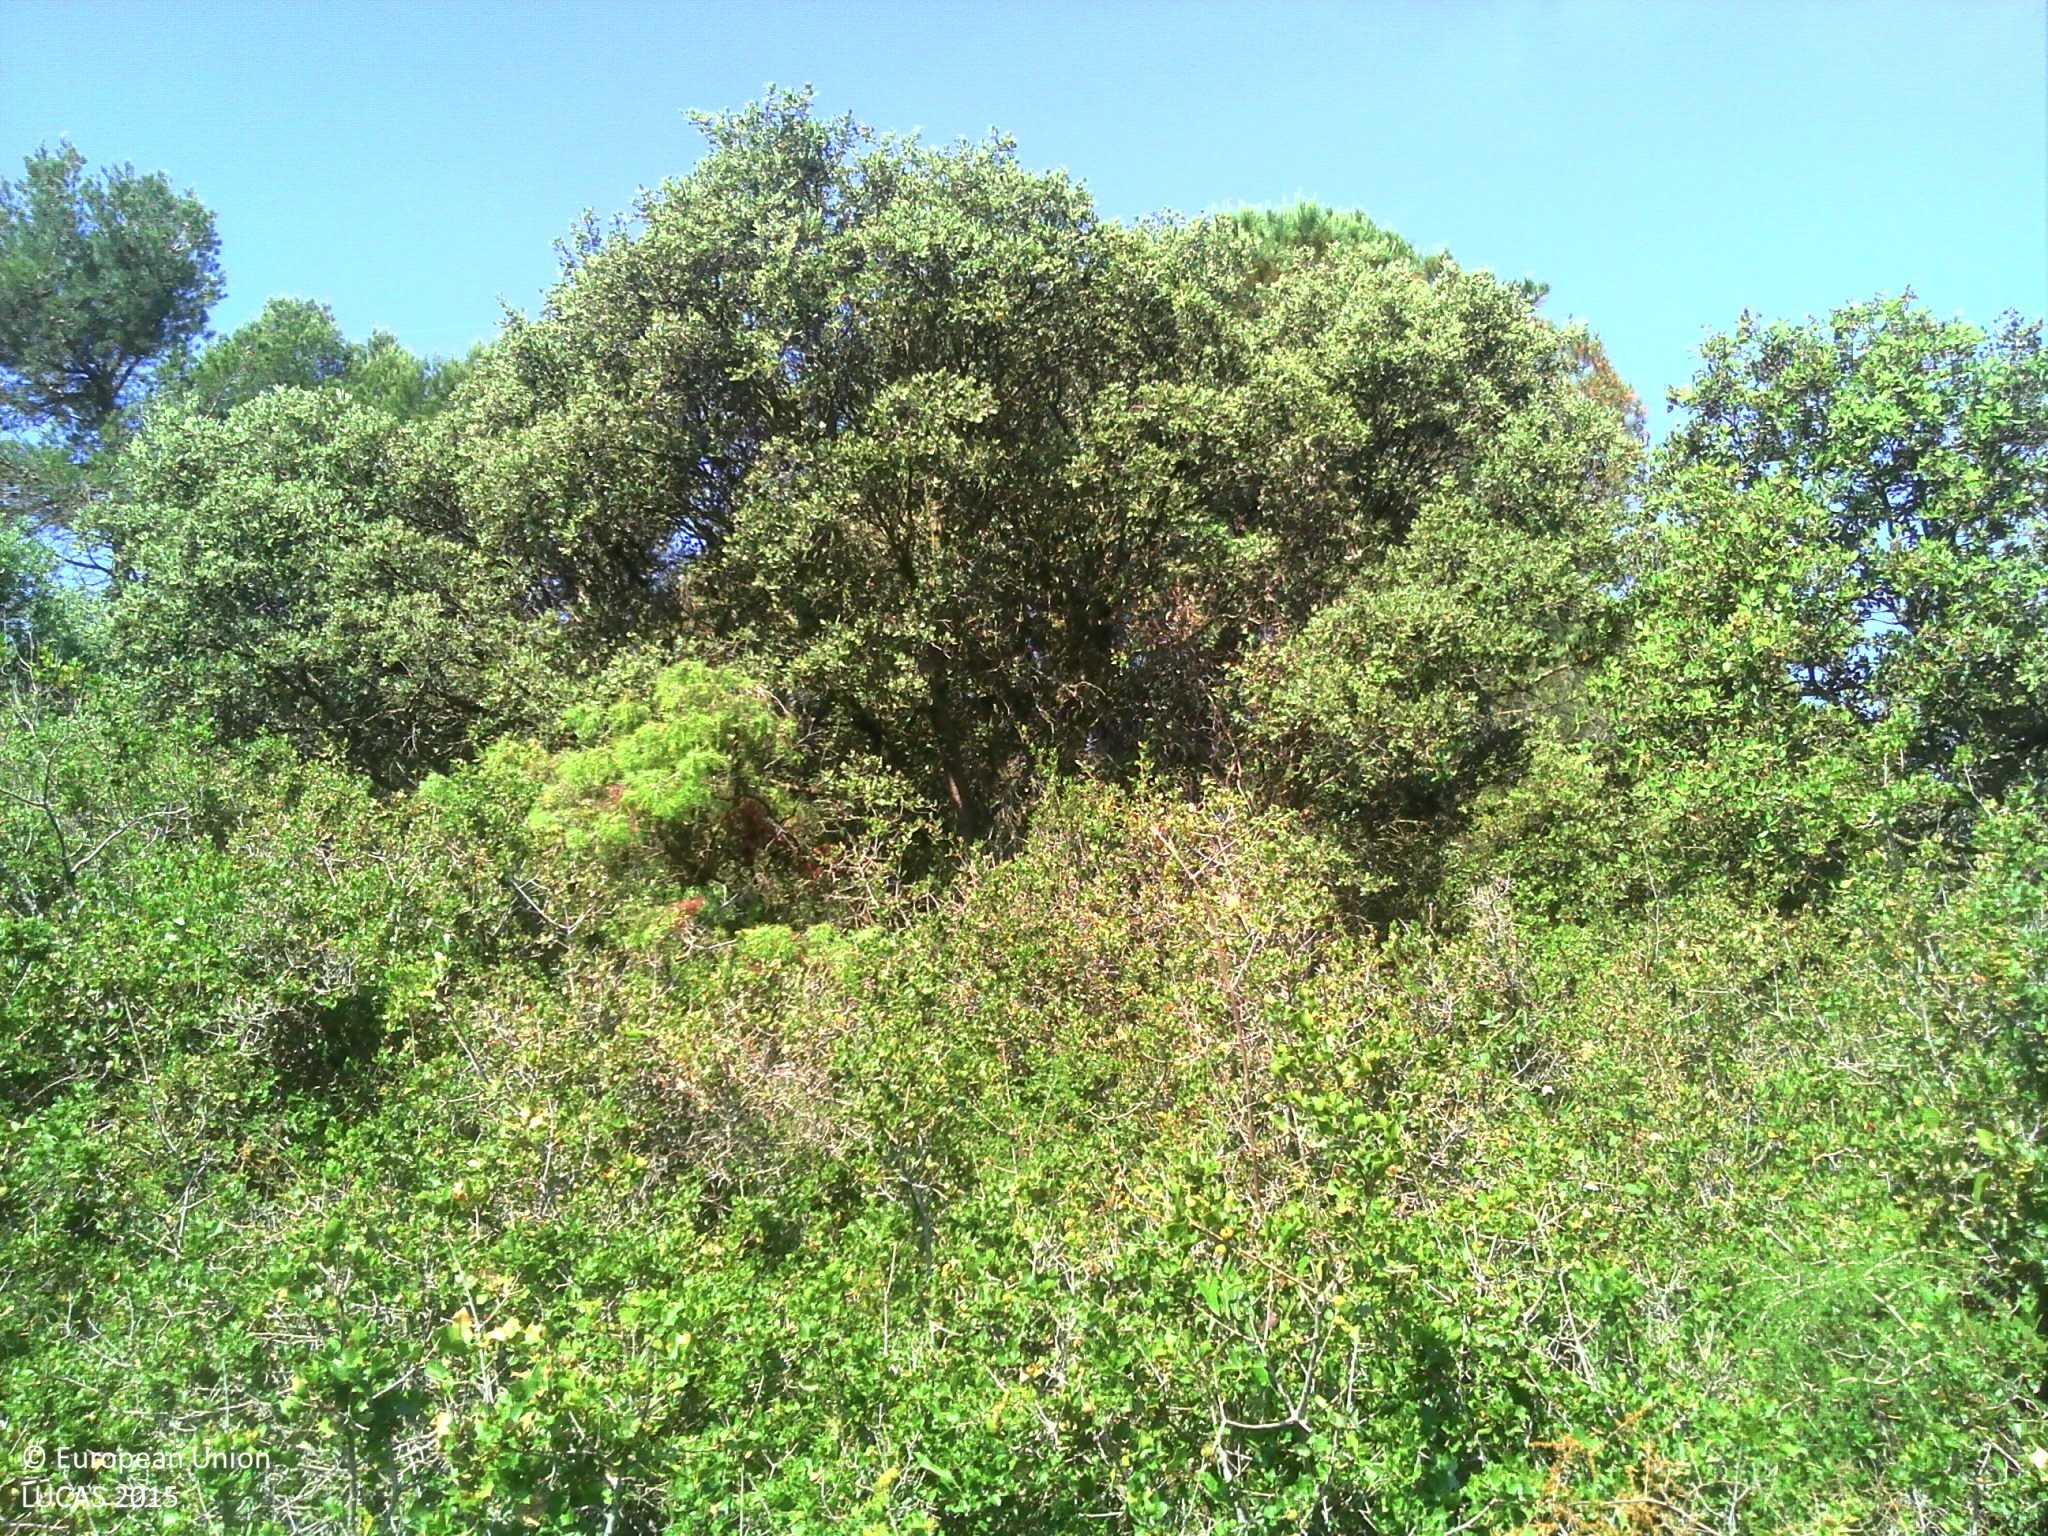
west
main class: Shrubland
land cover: Shrubland with sparse tree cover
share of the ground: > 75 %
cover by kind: shrubs 95 %, coniferous forest trees 5 %
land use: Semi-natural and natural areas not in use
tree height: > 5 m
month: June
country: FR
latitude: 43.1979
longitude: 3.1060
